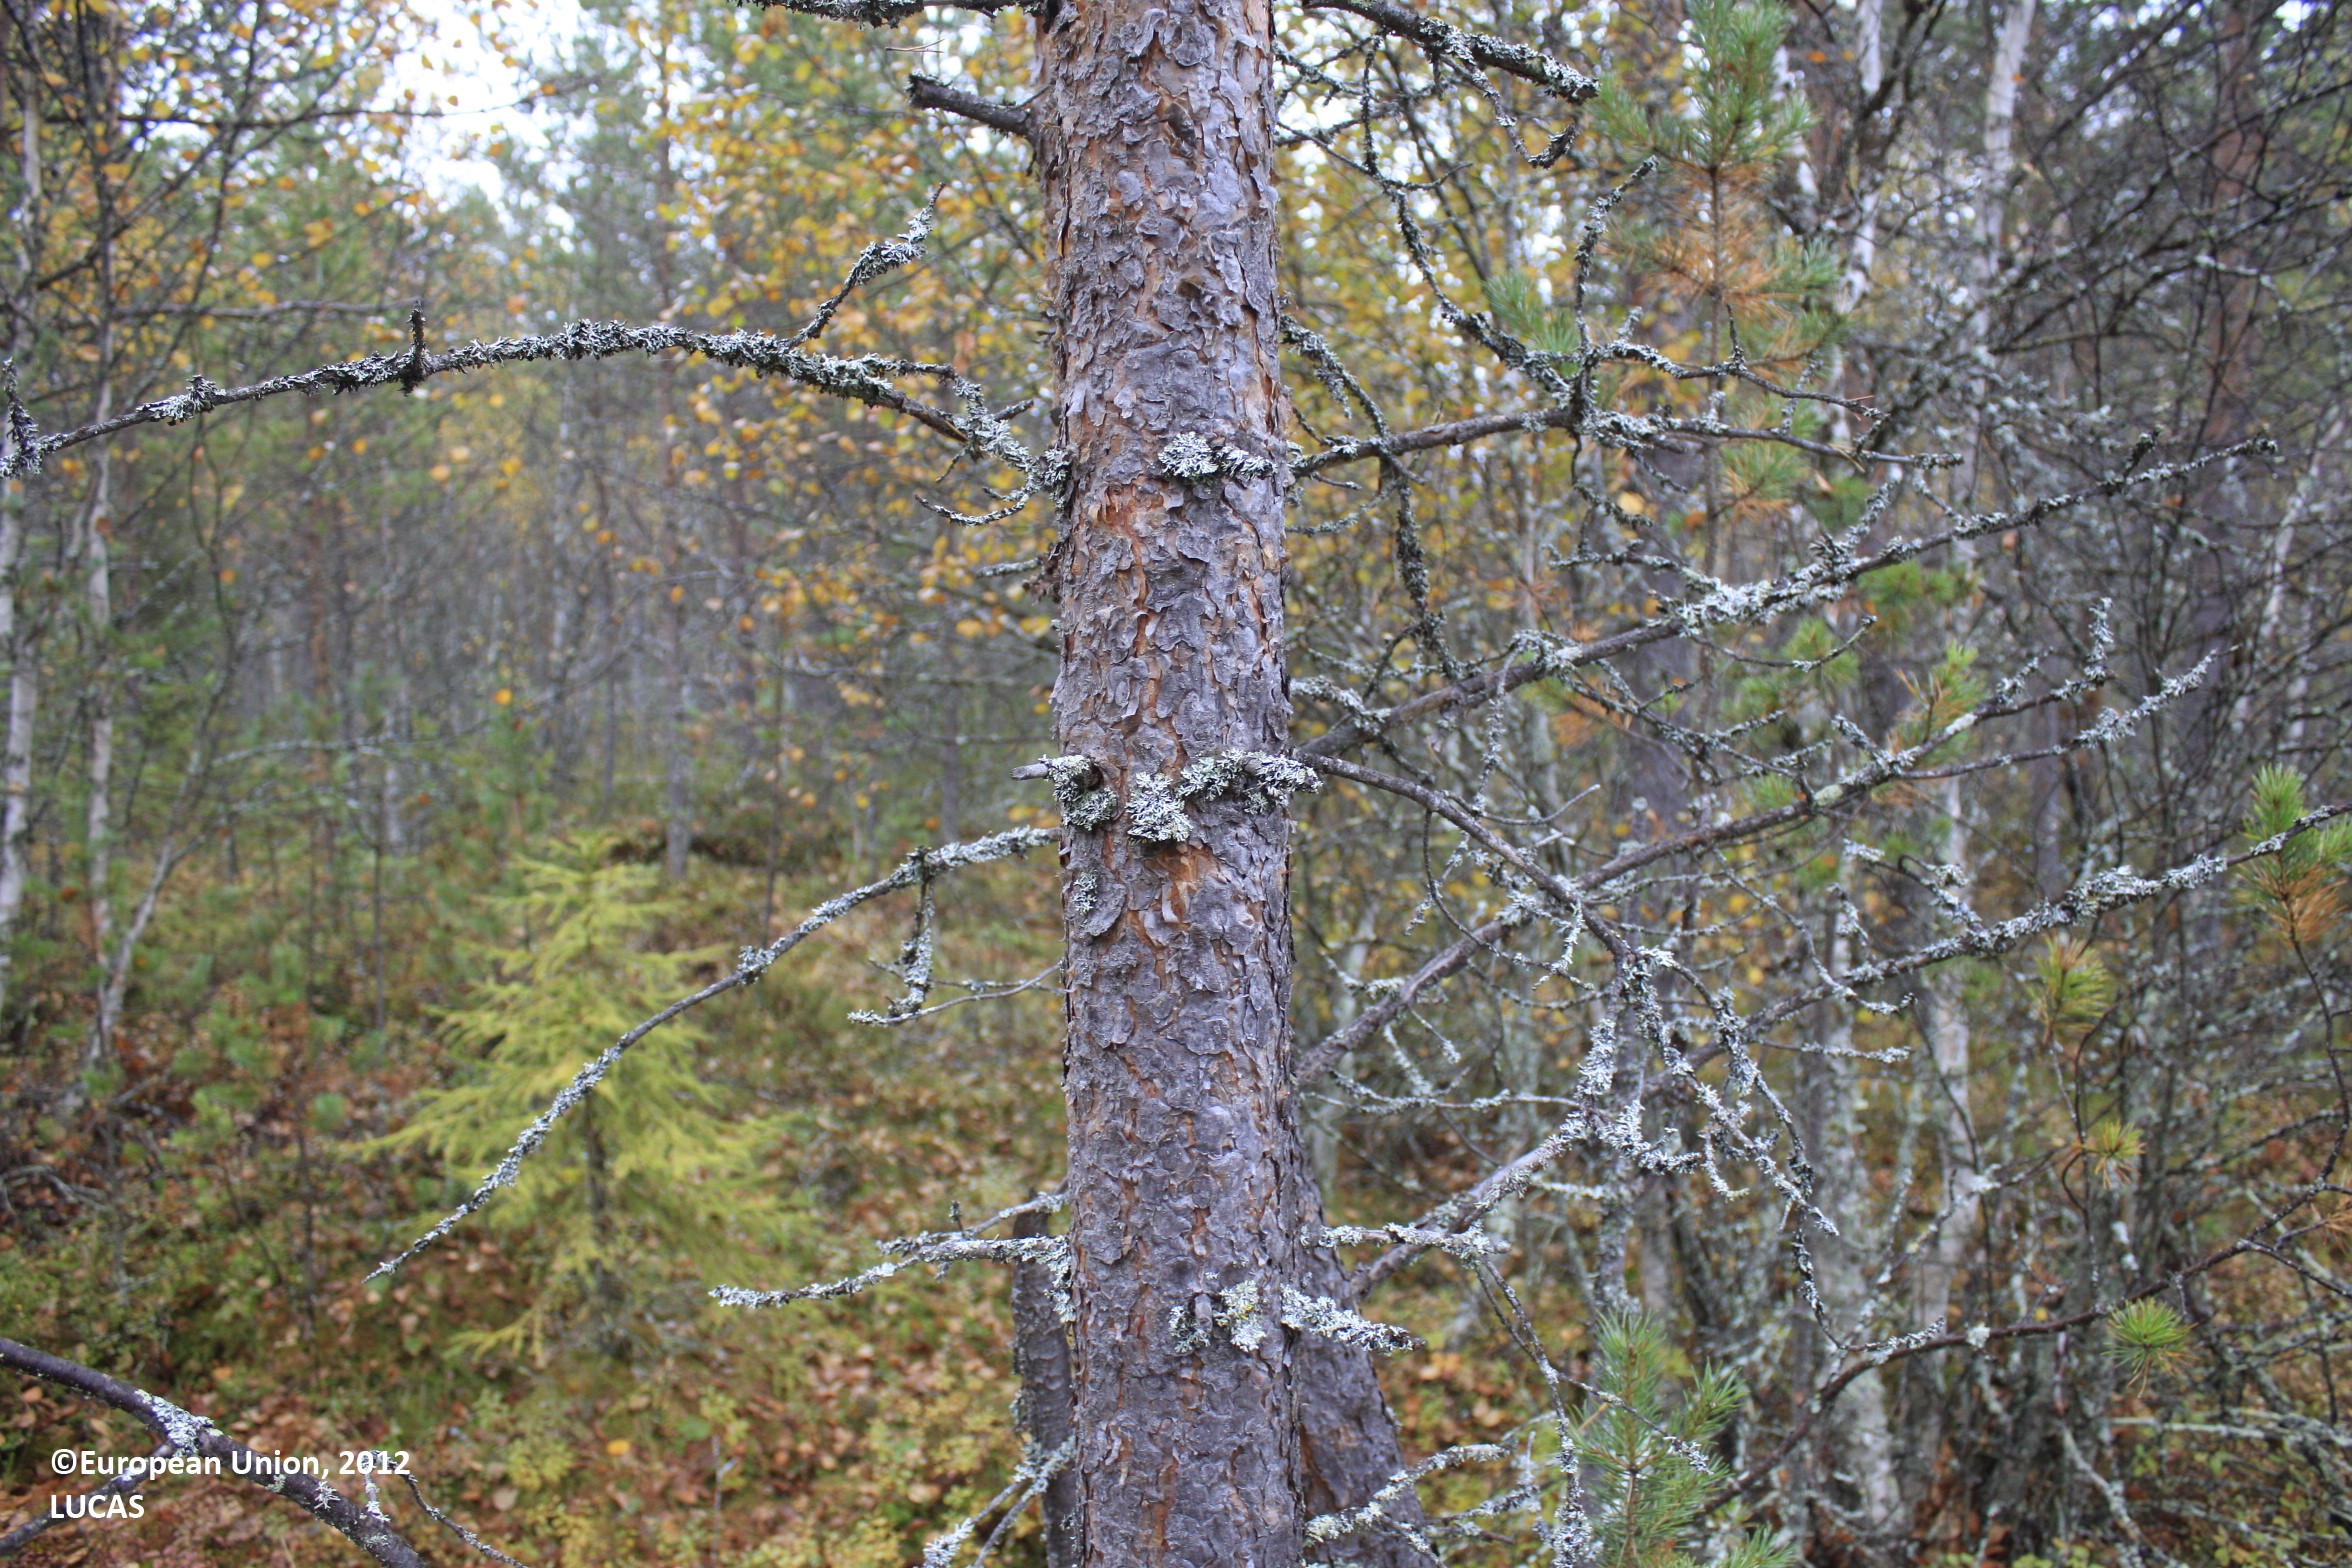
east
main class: Woodland
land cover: Pine dominated mixed woodland
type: mire and swamp forests
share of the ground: 25 - 50 %
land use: Forestry
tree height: > 5 m
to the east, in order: Pine dominated mixed woodland; Fences; Pine dominated mixed woodland; Ditches and canals; Pine dominated mixed woodland; Ditches and canals; Broadleaved woodland; Peatbogs
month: September
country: FI
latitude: 65.7495
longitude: 27.4264
